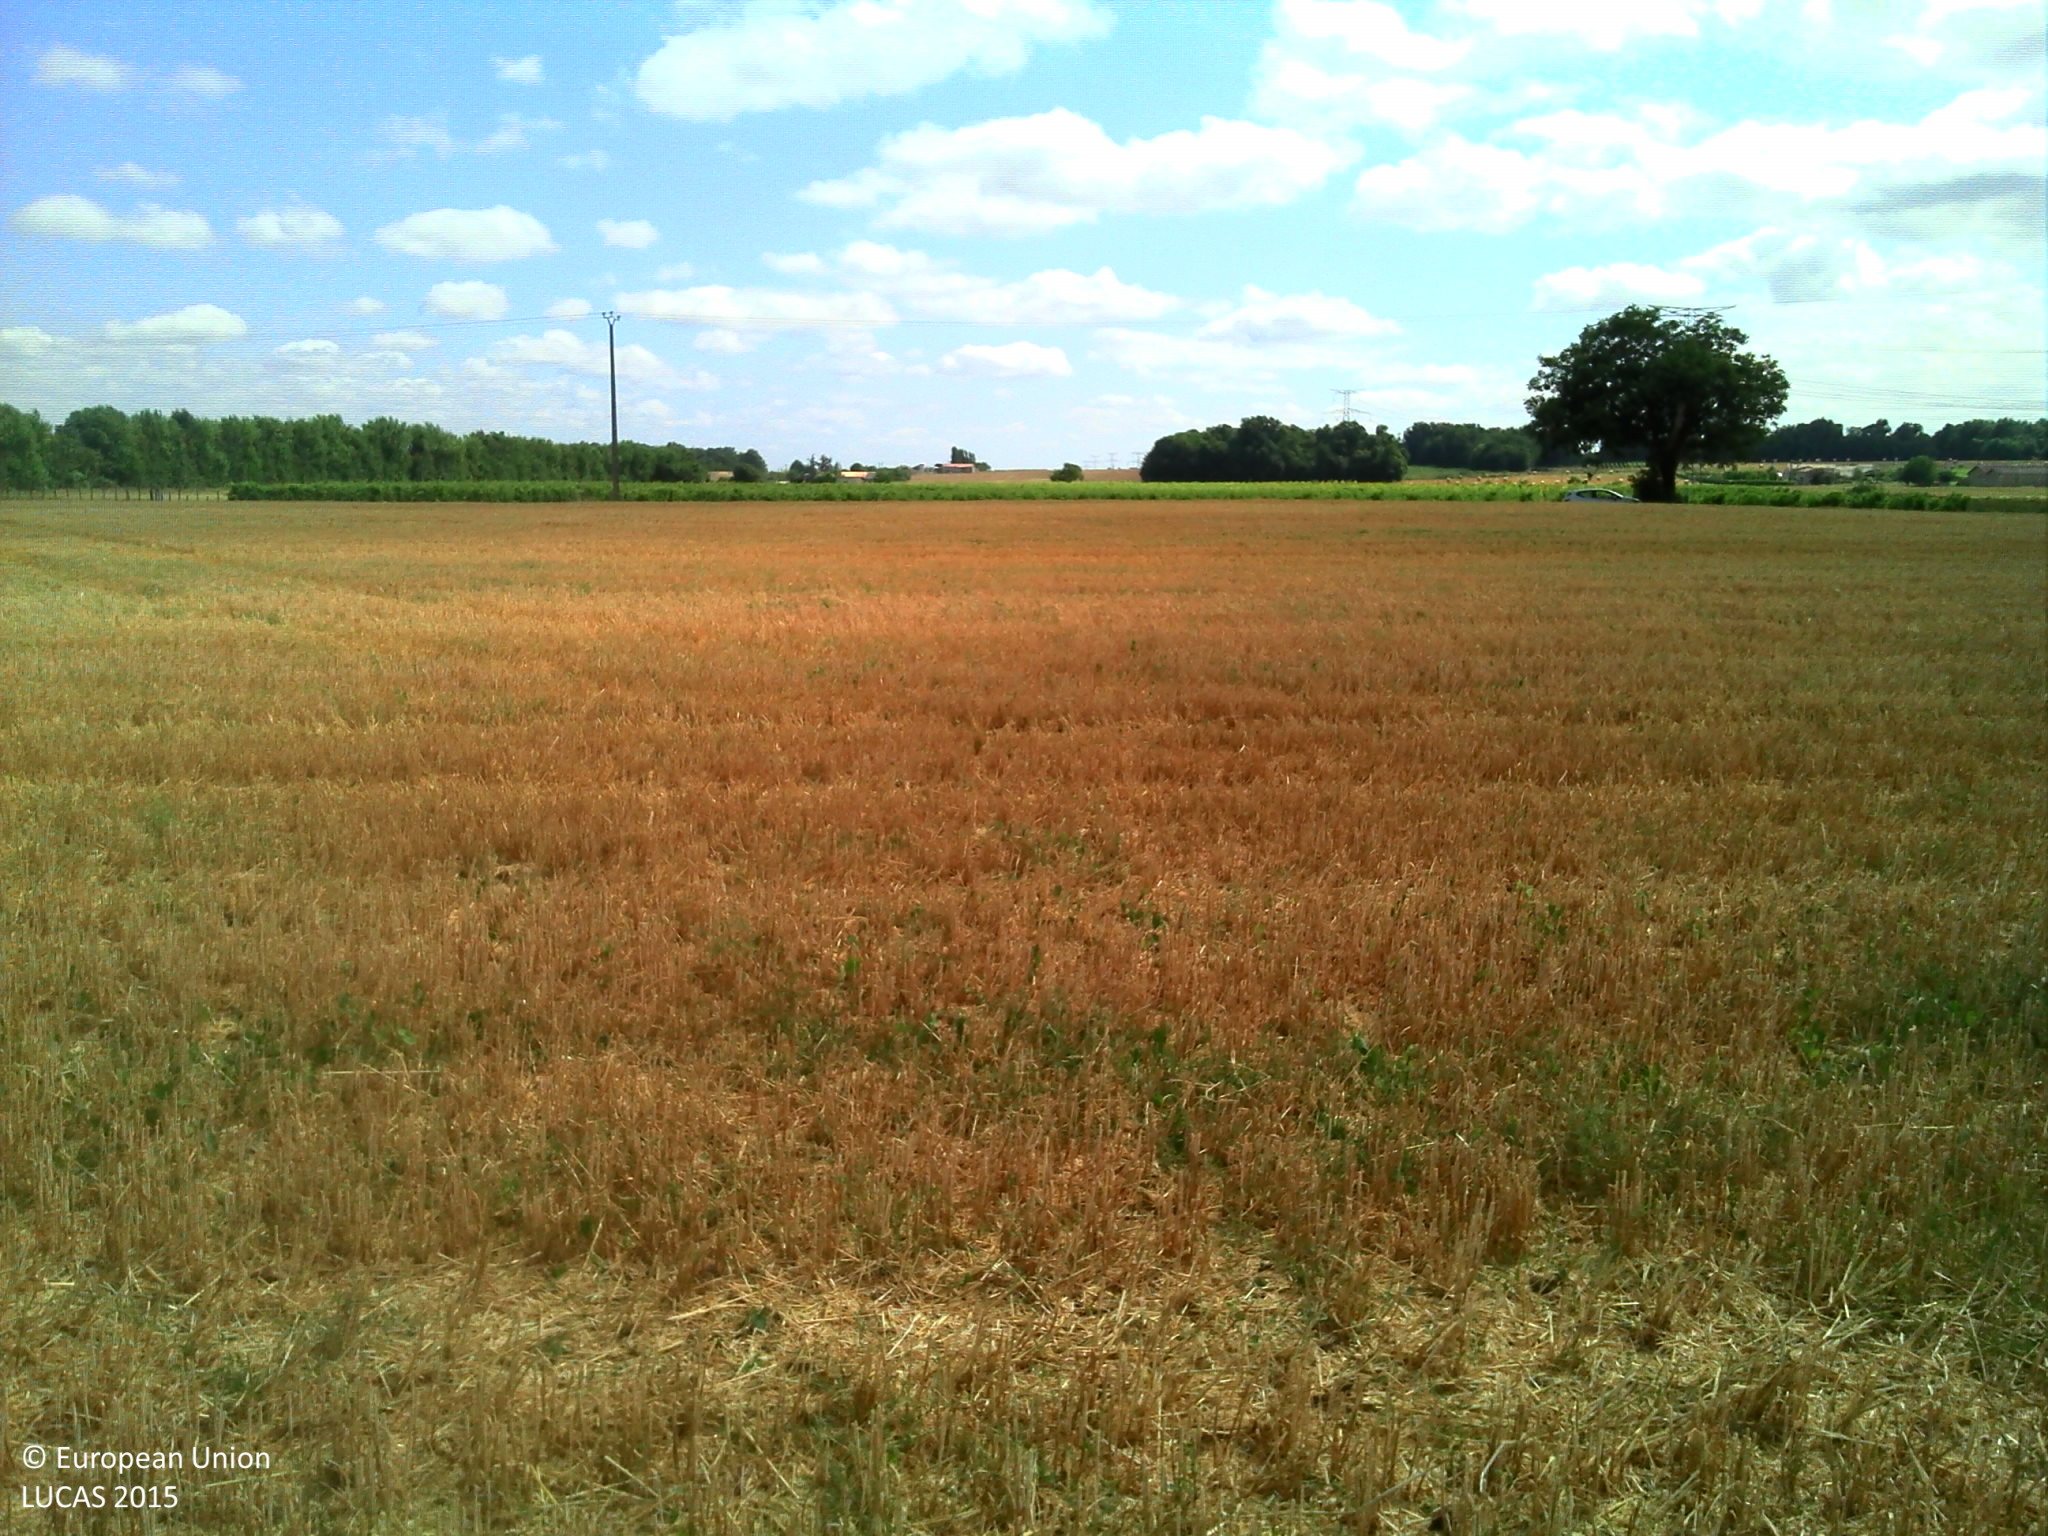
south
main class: Cropland
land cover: Durum wheat
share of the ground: > 75 %
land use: Agriculture (excluding fallow land and kitchen gardens)
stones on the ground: 10 - 25 %
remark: Harvested field
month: July
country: FR
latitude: 45.4955
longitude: -0.6054
